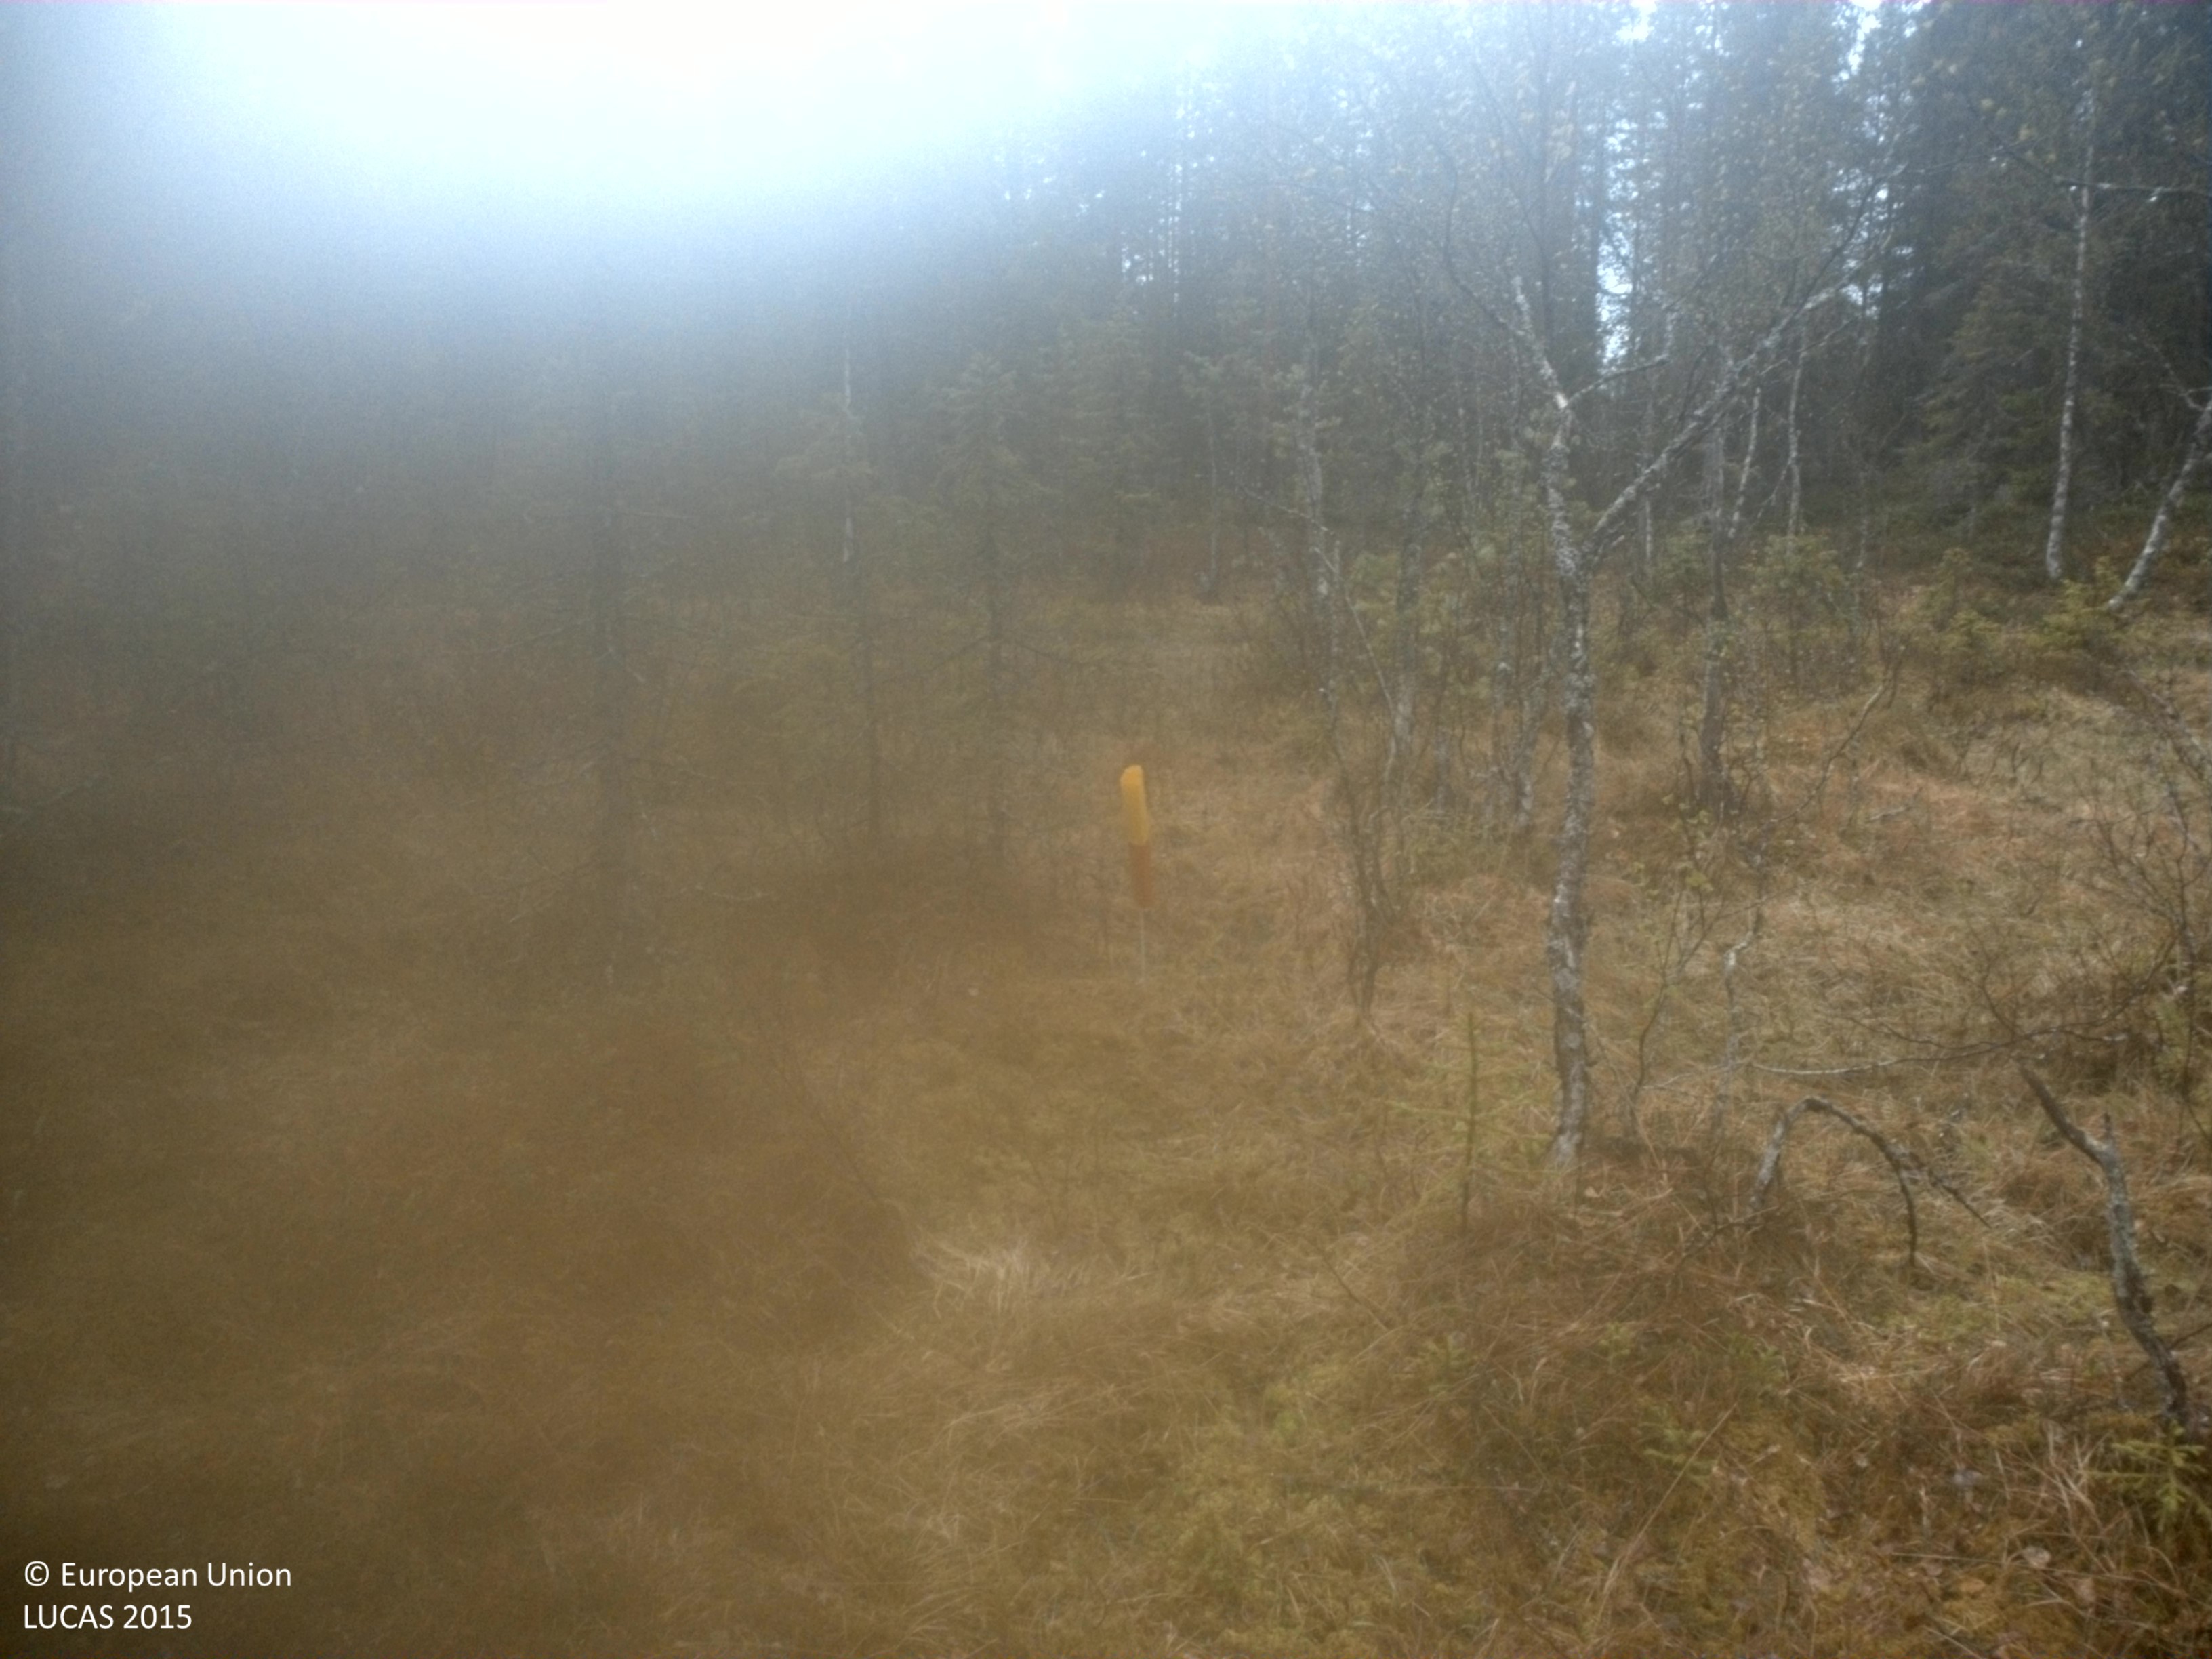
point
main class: Woodland
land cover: Spruce dominated mixed woodland
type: boreal forest
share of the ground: 25 - 50 %
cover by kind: lichens and mosses 35 %, coniferous forest trees 30 %, herbaceous plants 20 %, broadleaved forest trees 10 %, shrubs 5 %
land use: Forestry
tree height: > 5 m
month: June
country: SE
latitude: 64.3185
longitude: 18.0968
